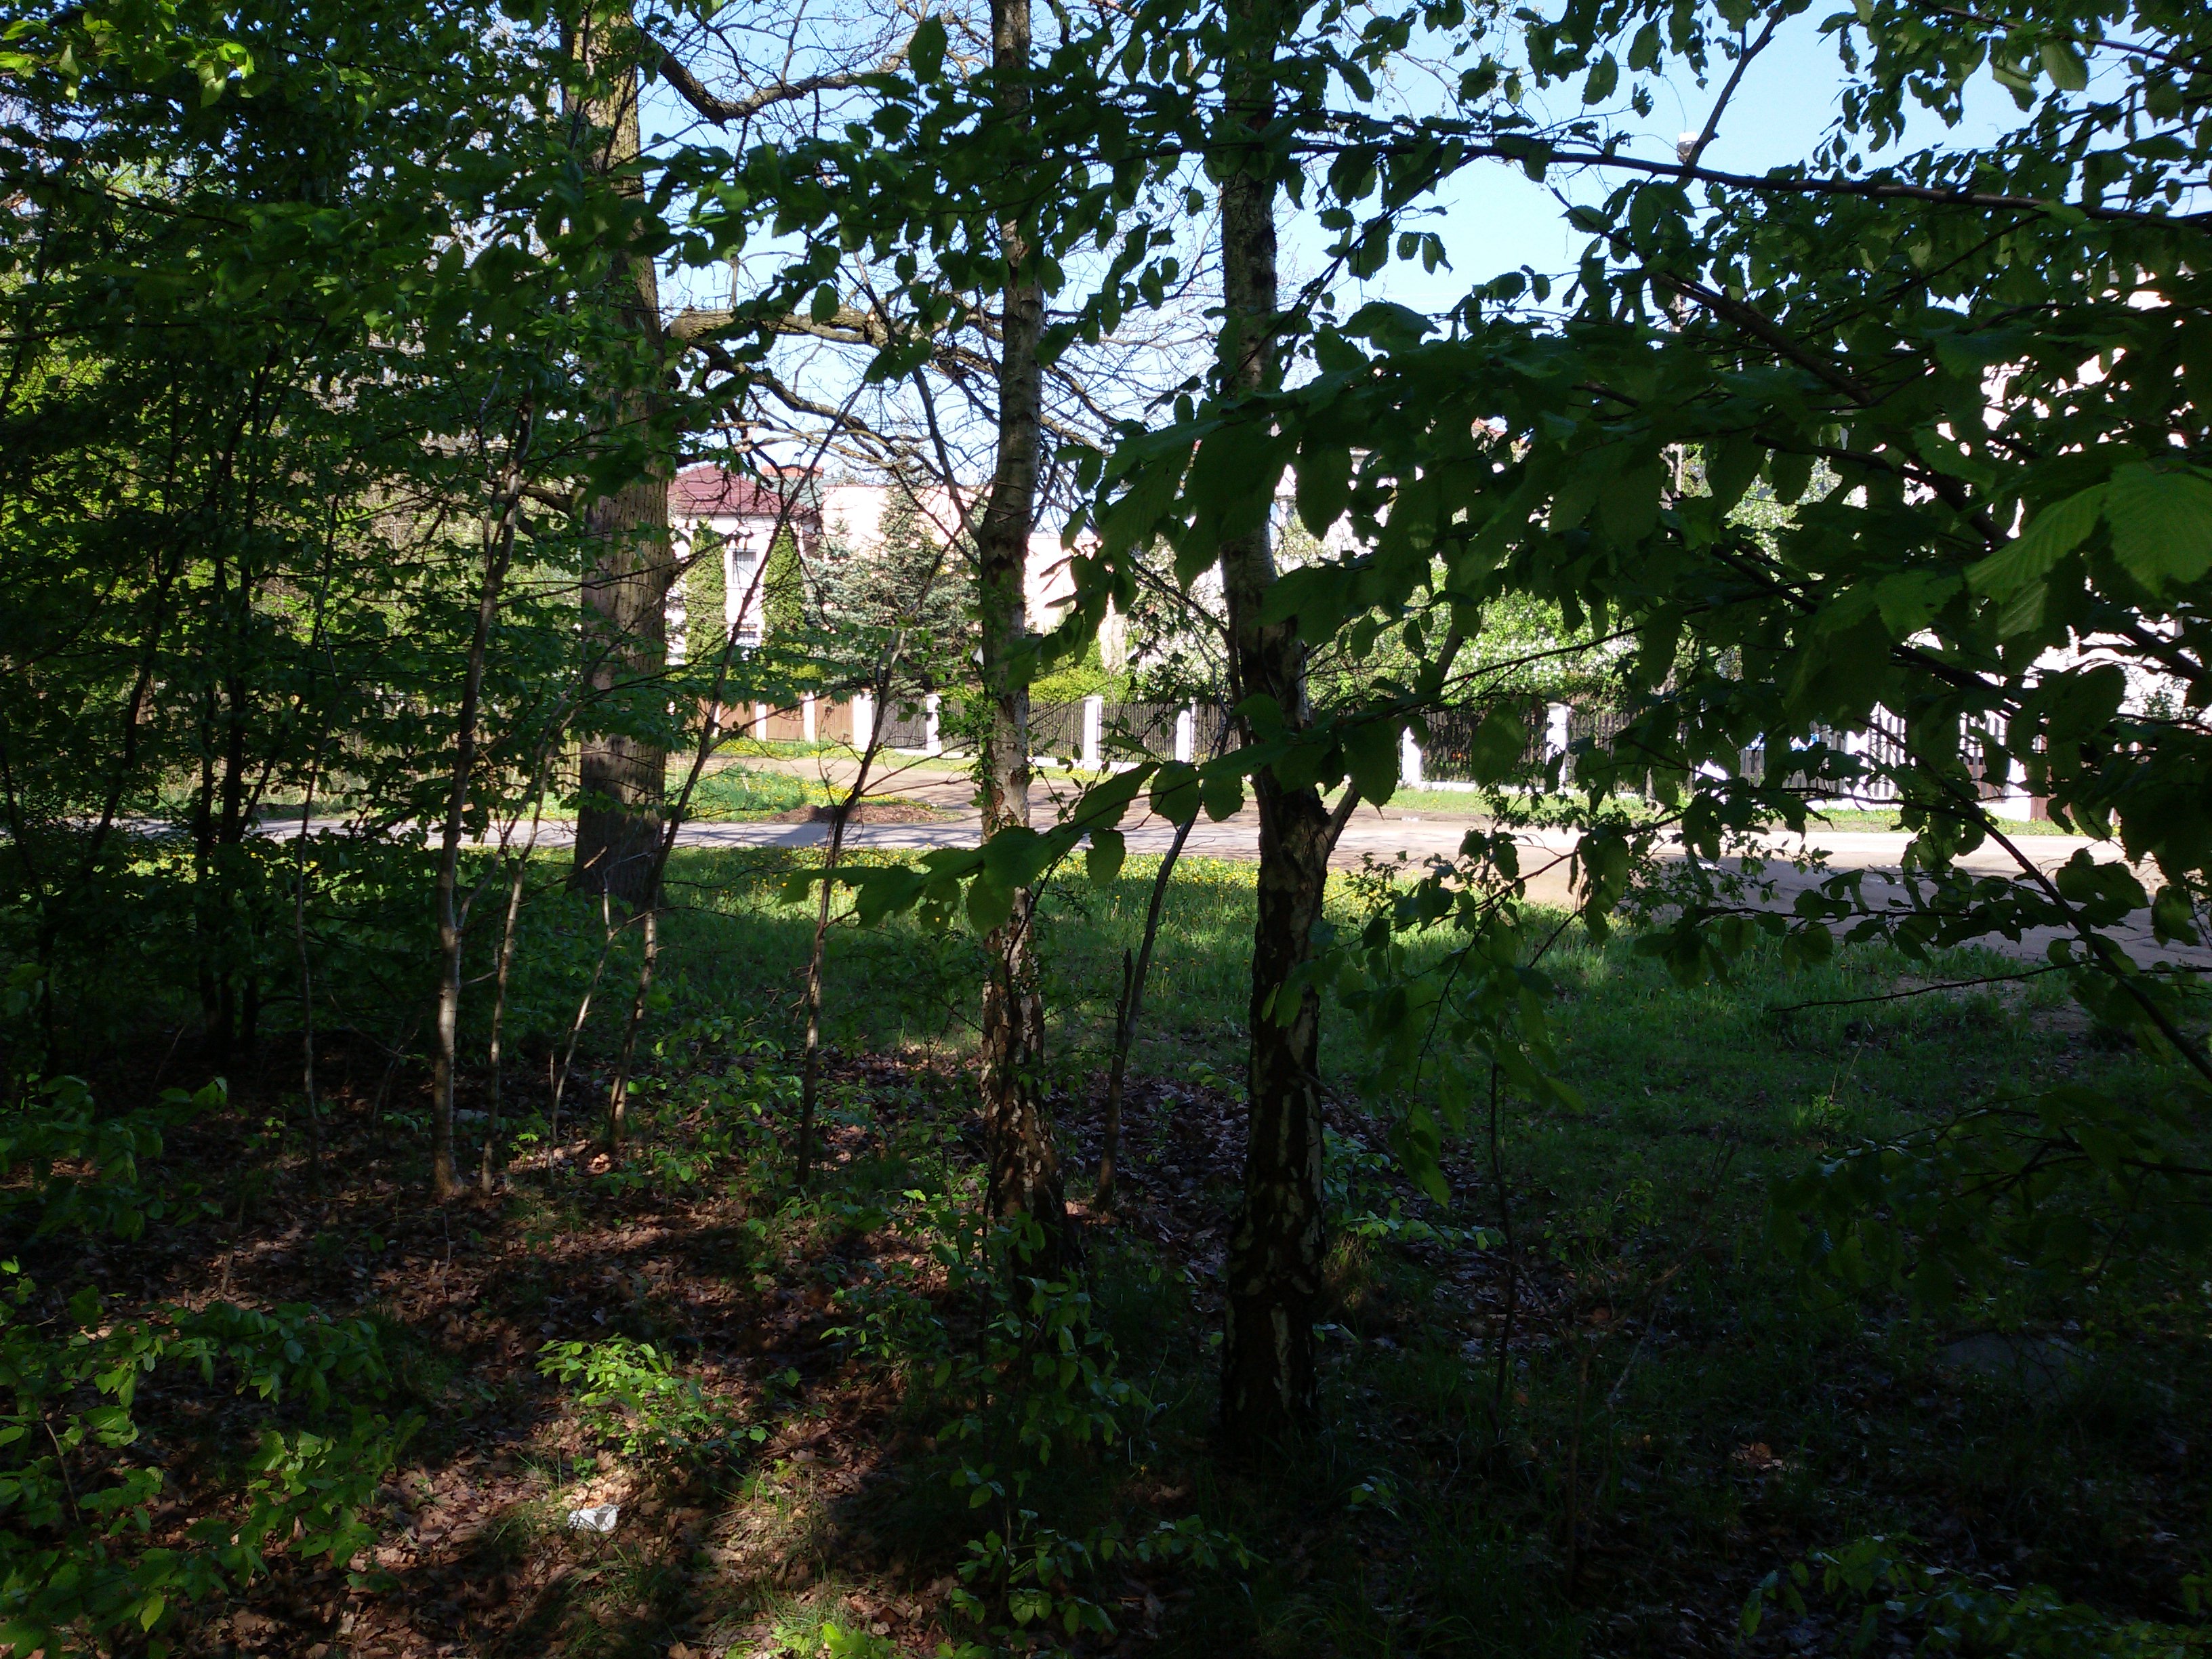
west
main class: Woodland
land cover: Broadleaved woodland
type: mesophytic deciduous forest
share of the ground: > 75 %
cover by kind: broadleaved forest trees 100 %
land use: Forestry
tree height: > 5 m
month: May
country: PL
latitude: 52.0101
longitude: 23.1166
